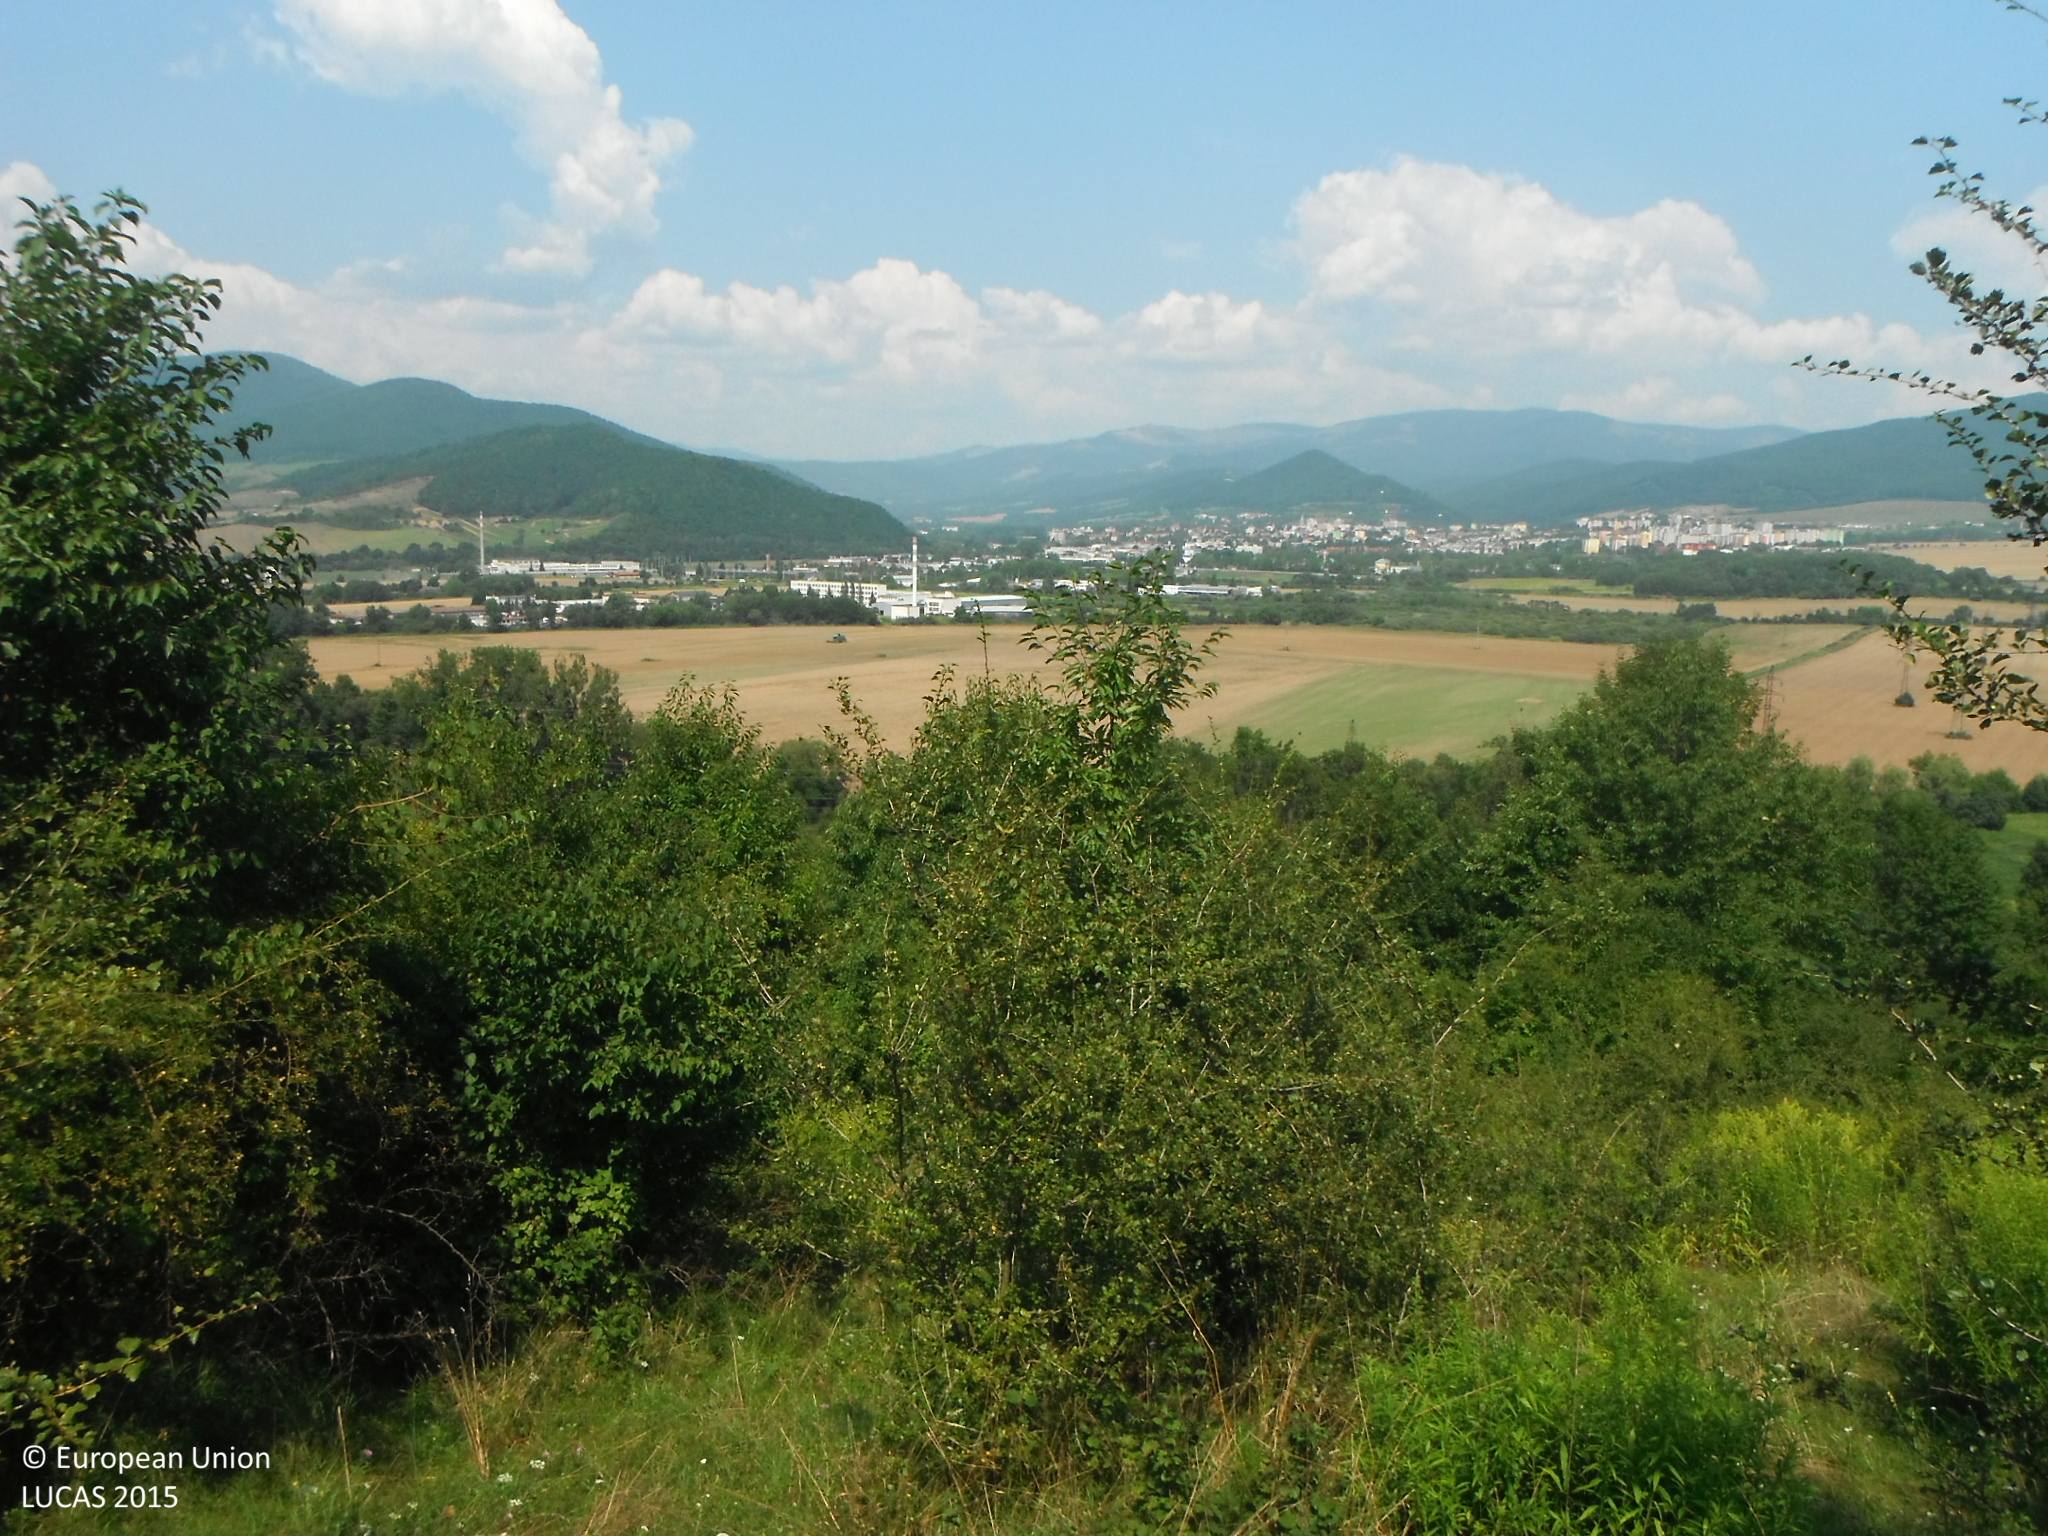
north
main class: Shrubland
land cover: Shrubland with sparse tree cover
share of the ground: > 75 %
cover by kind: shrubs 95 %, broadleaved forest trees 5 %
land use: Semi-natural and natural areas not in use
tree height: > 5 m
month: August
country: SK
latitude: 48.6257
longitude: 20.5230
